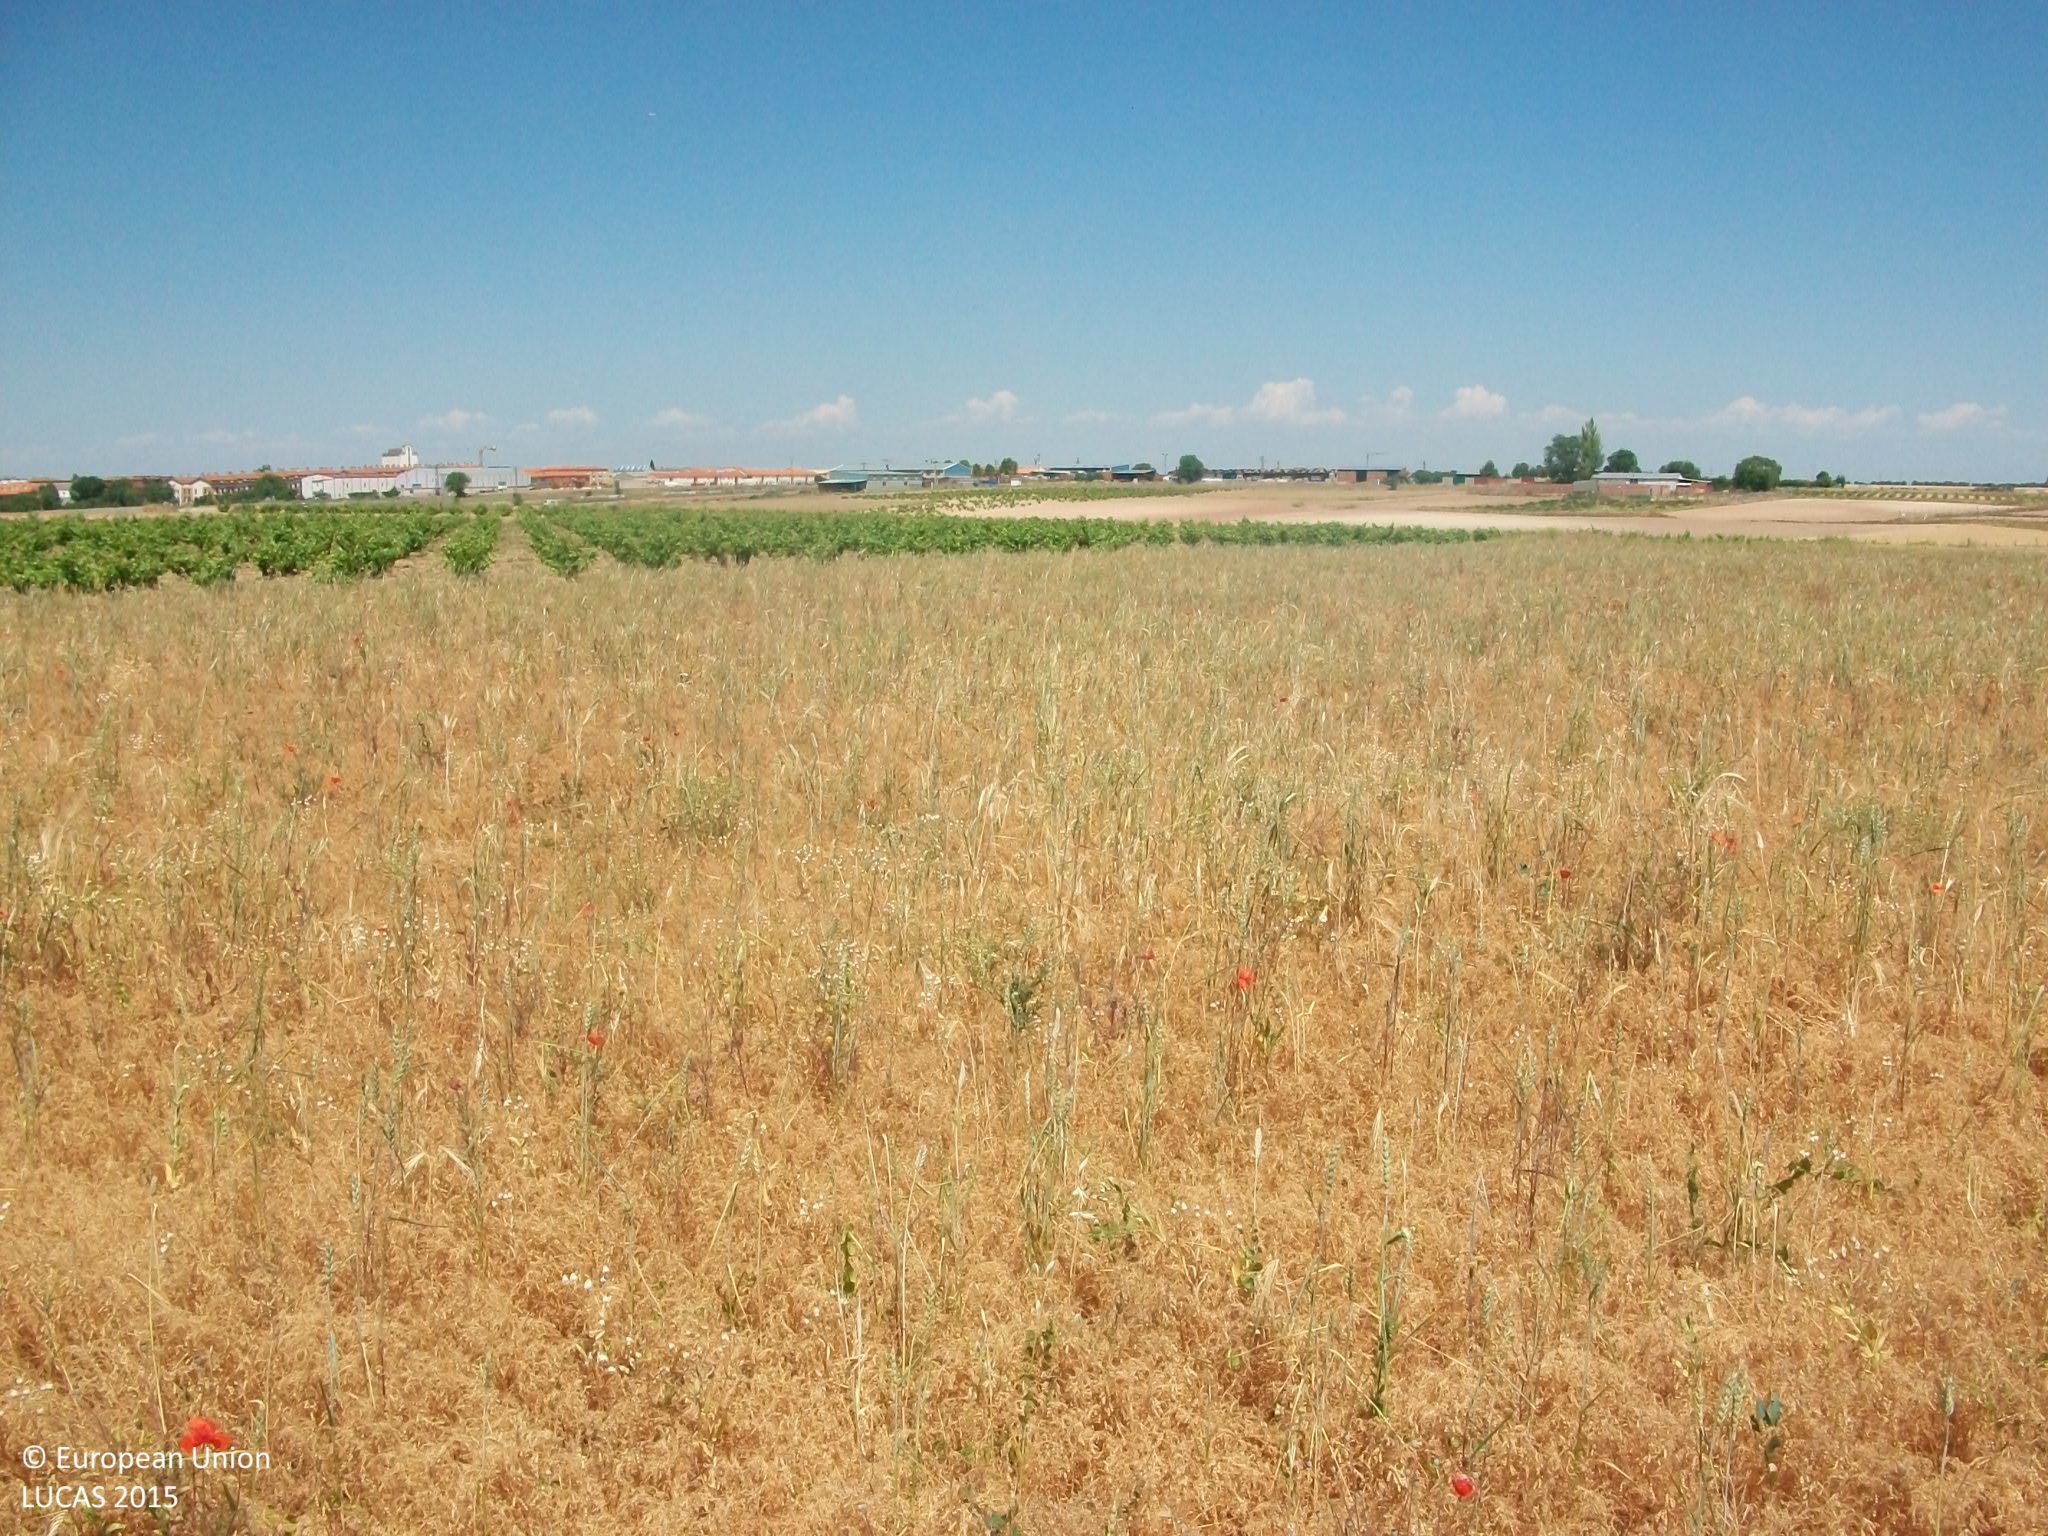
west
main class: Cropland
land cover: Common wheat
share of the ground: > 75 %
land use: Agriculture (excluding fallow land and kitchen gardens)
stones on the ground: > 50 %
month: May
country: ES
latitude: 39.9004
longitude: -3.6089
